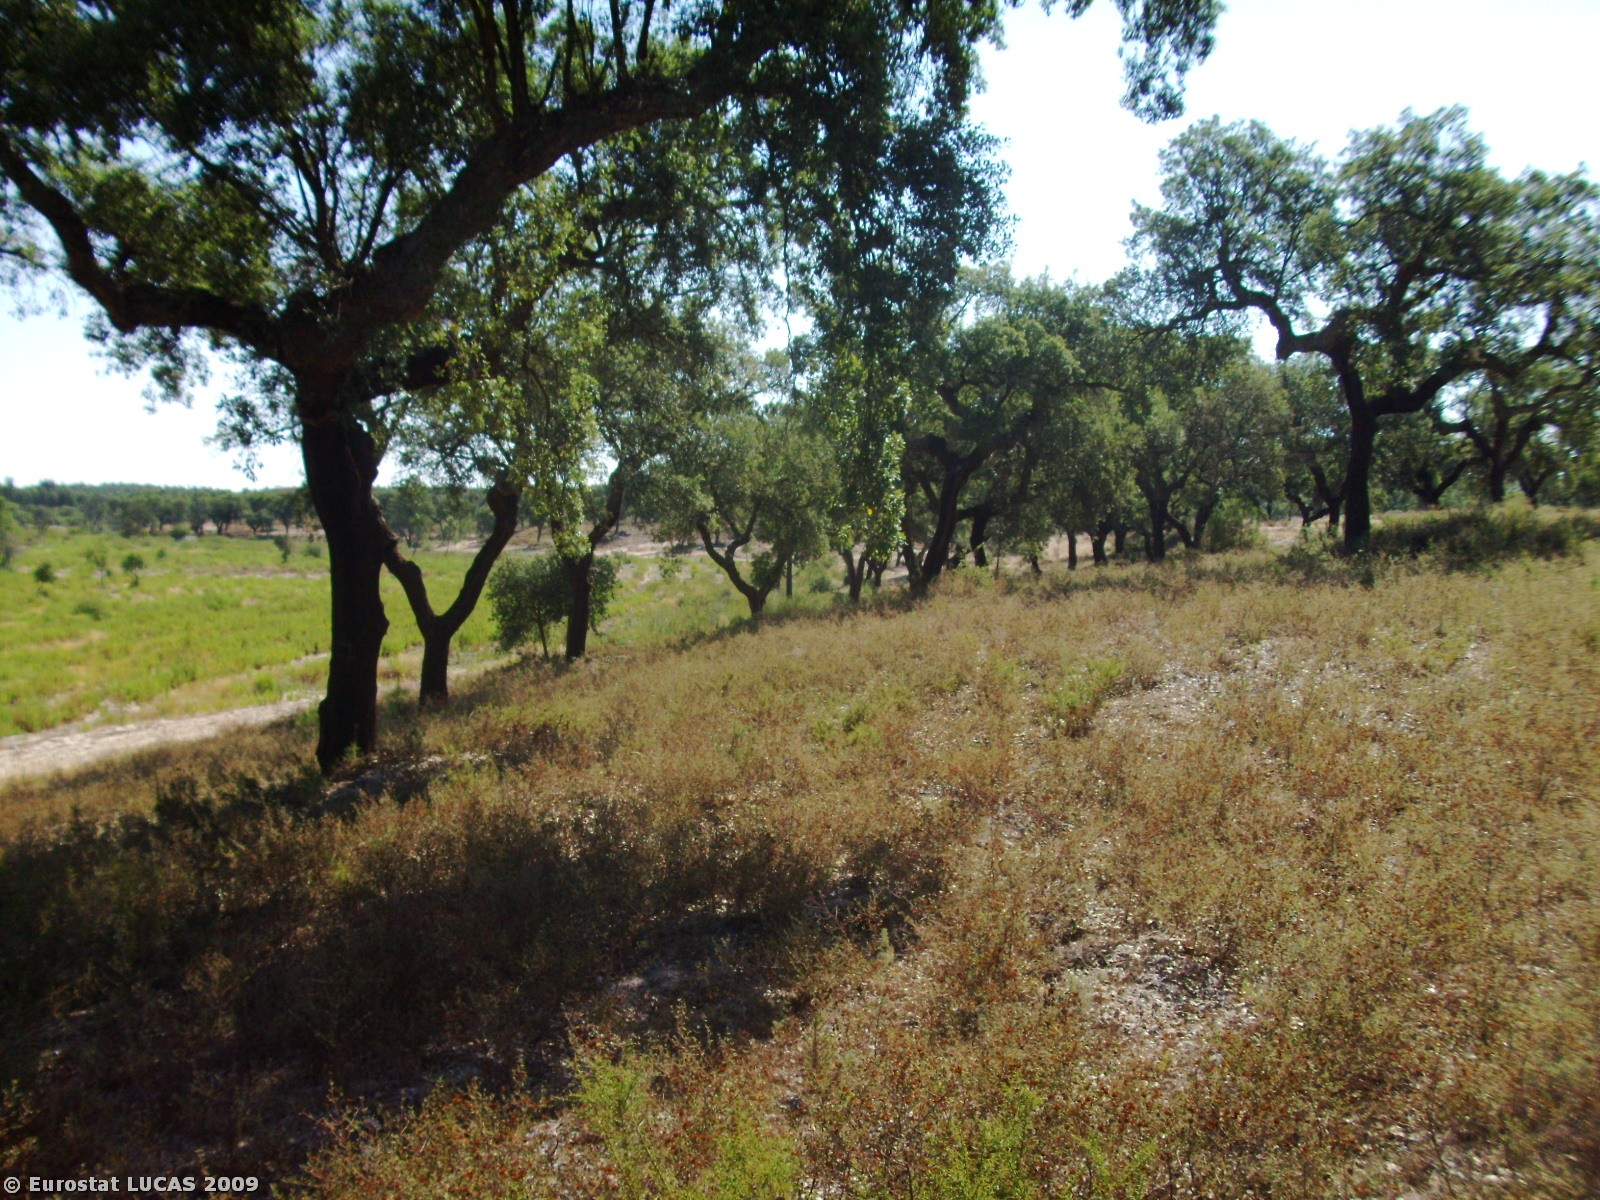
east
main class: Woodland
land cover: Broadleaved woodland
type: broadleaved evergreen forest
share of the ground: 25 - 50 %
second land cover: Spontaneously vegetated surfaces
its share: 25 - 50 %
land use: Forestry
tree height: > 5 m
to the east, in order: Broadleaved woodland; Spontaneously vegetated surfaces; Broadleaved woodland; Bare land; Broadleaved woodland; Tracks; Grass margins; Mixed woodland; Spontaneously vegetated surfaces; Grass margins; Bare land; Tracks; Spontaneously vegetated surfaces
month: August
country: PT
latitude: 39.2696
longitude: -8.1045
